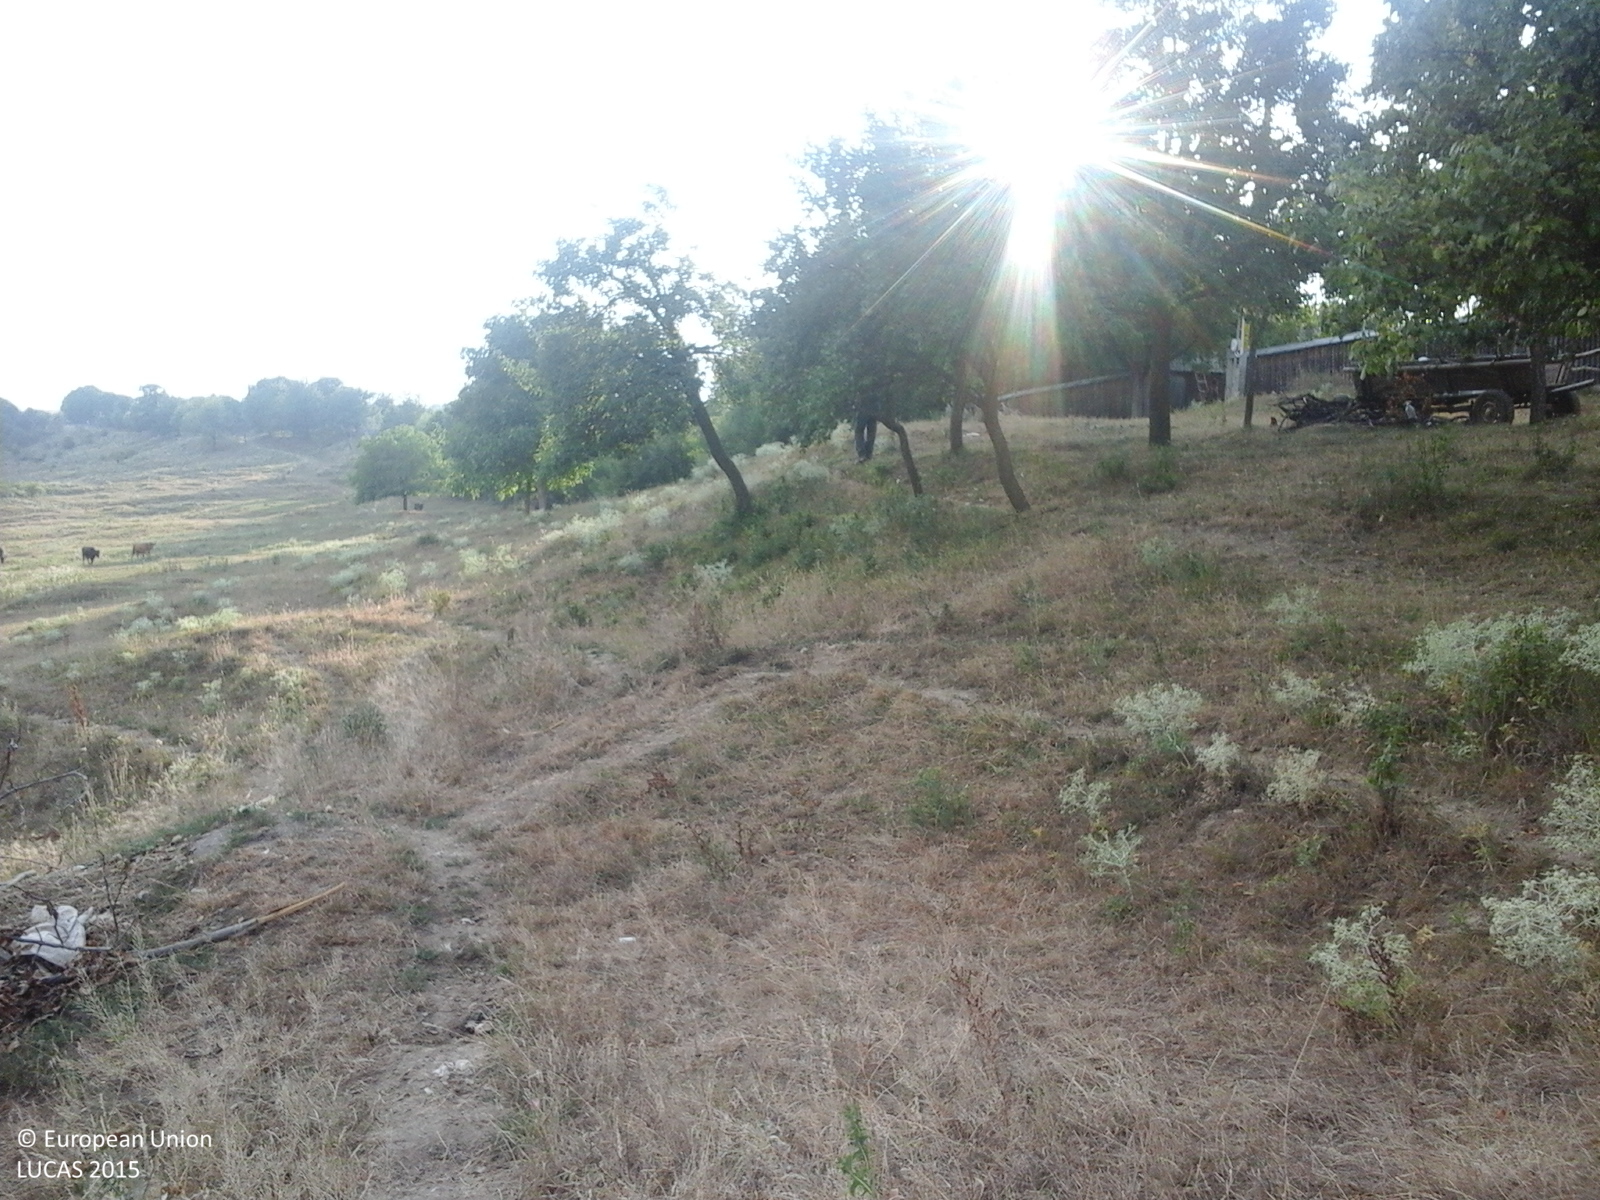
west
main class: Grassland
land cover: Grassland with sparse tree/shrub cover
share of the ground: > 75 %
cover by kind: herbaceous plants 90 %, broadleaved forest trees 5 %, shrubs 5 %
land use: Agriculture (excluding fallow land and kitchen gardens)
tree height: > 5 m
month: July
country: RO
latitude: 46.1885
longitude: 26.7885
